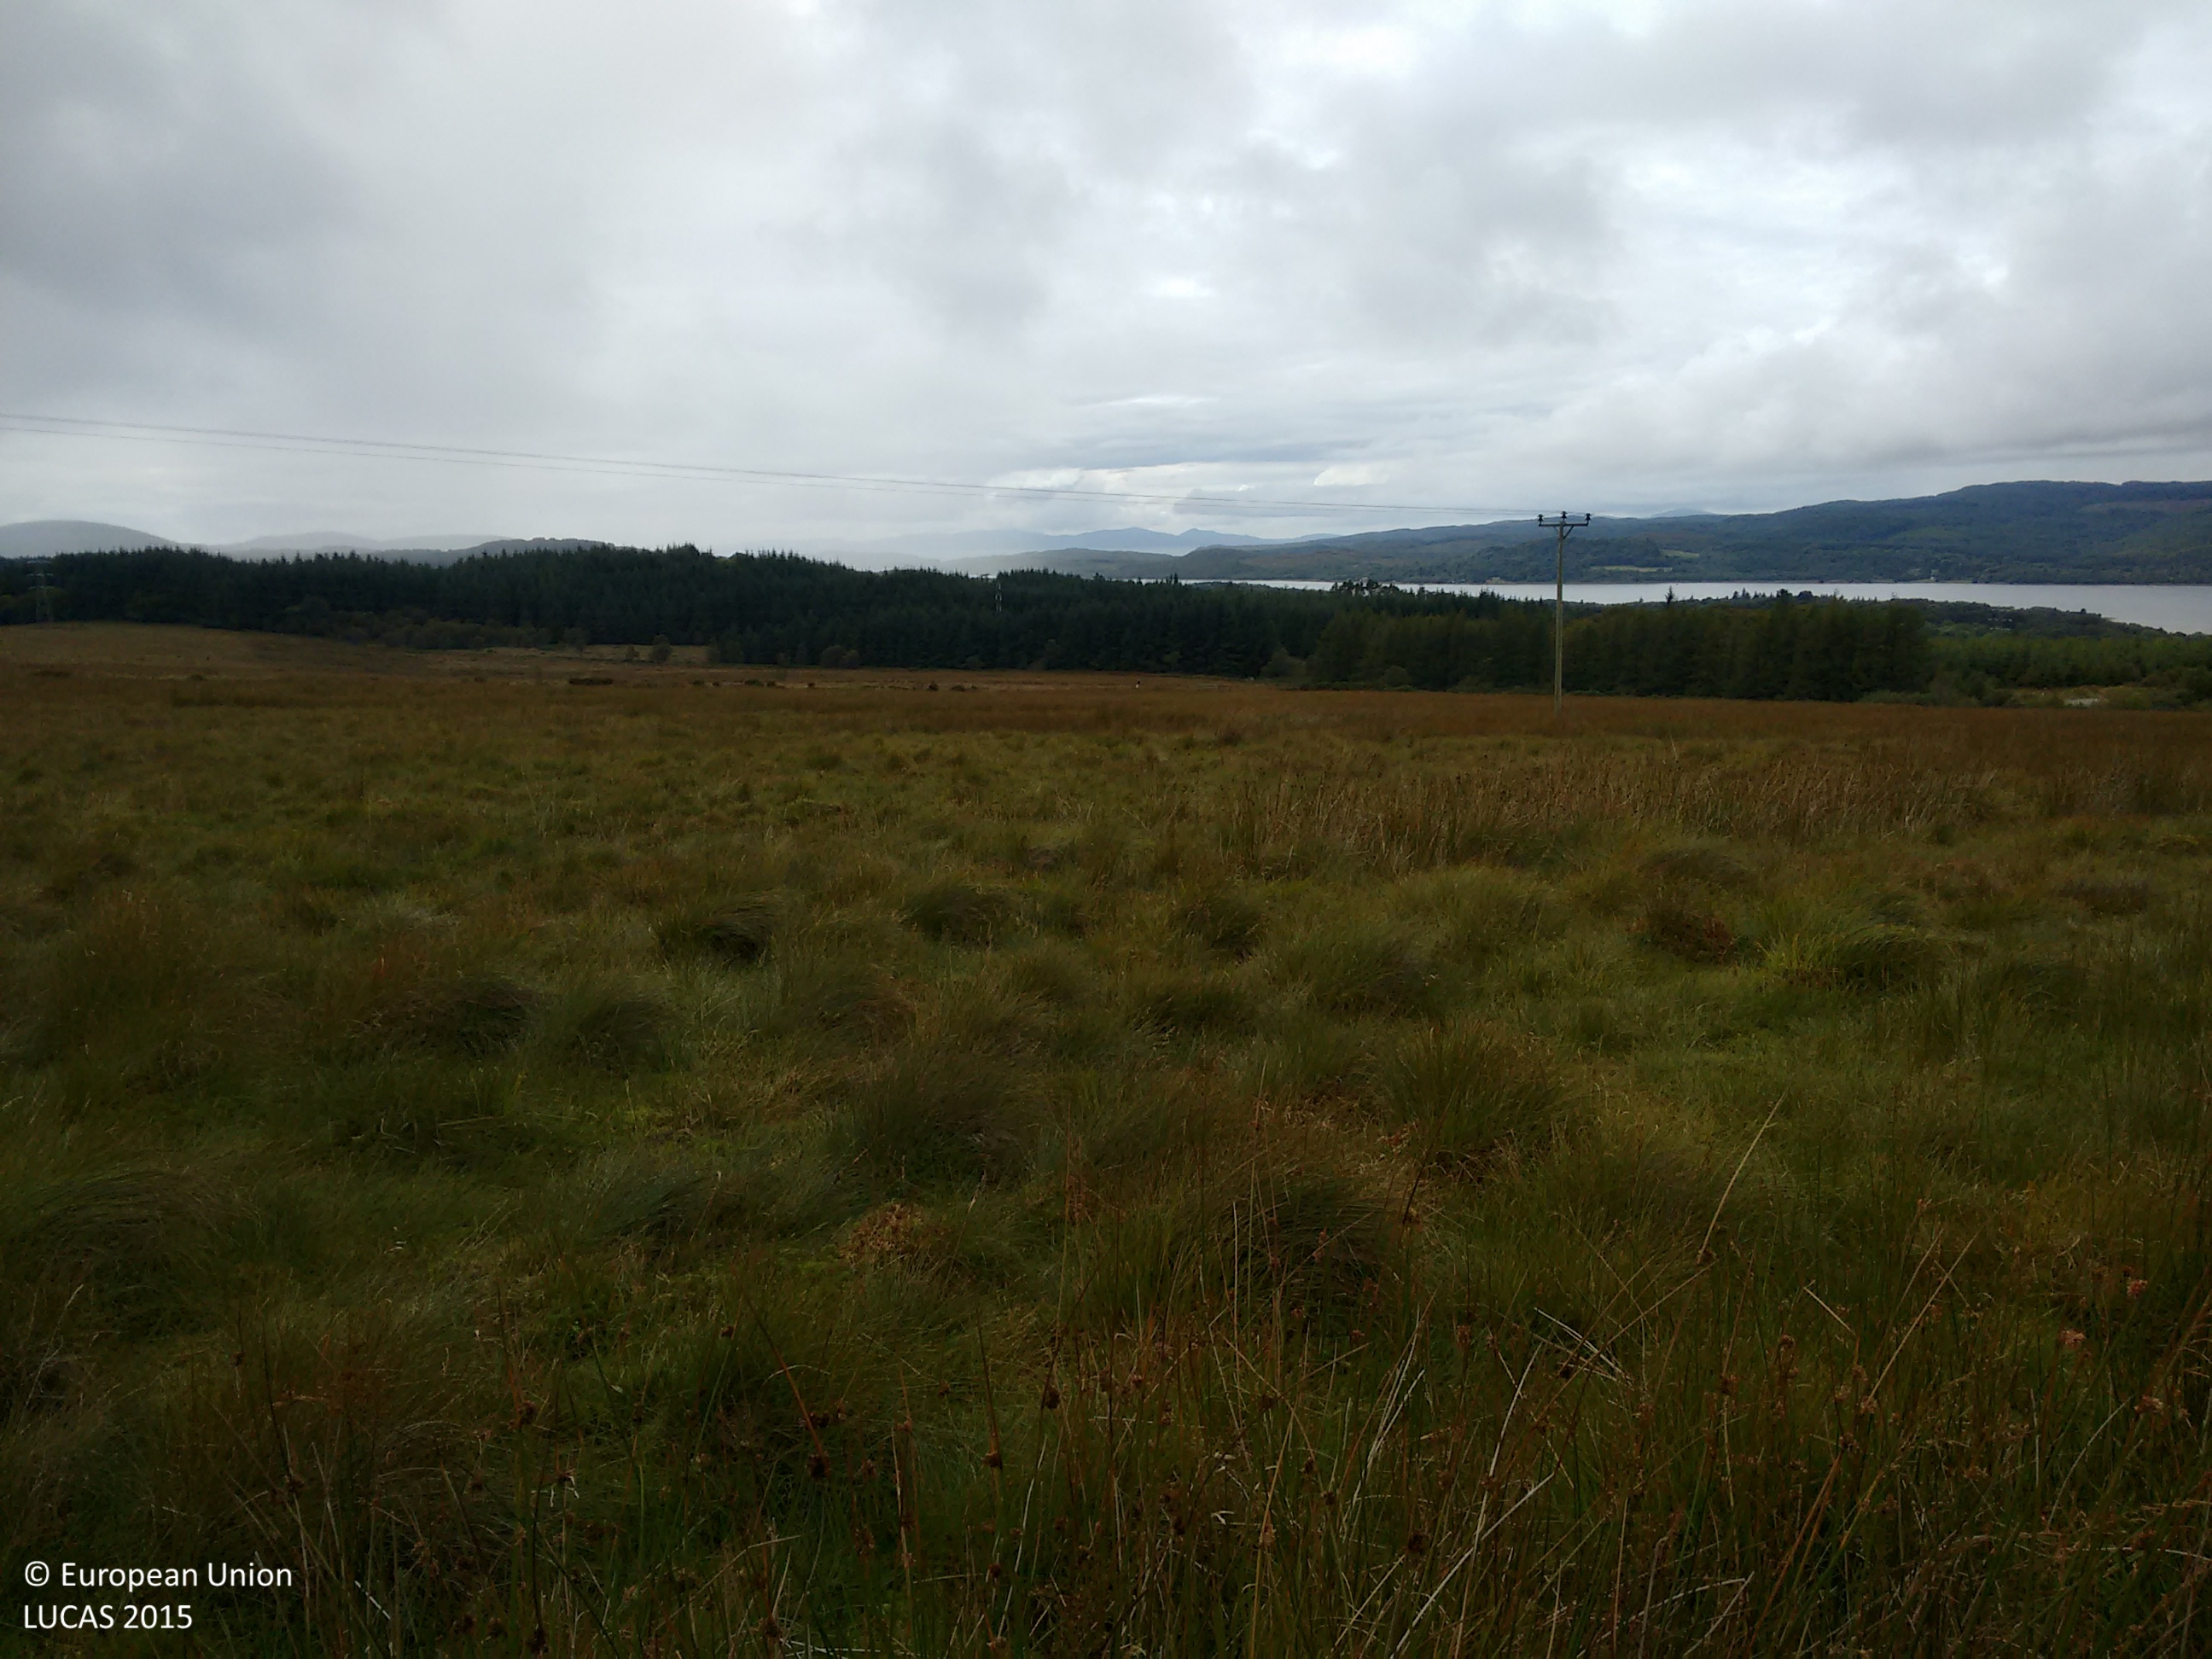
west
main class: Grassland
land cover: Grassland without tree/shrub cover
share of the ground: > 75 %
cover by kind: herbaceous plants 90 %, lichens and mosses 10 %
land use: Agriculture (excluding fallow land and kitchen gardens)
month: September
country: GB
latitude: 55.7941
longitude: -5.4498
